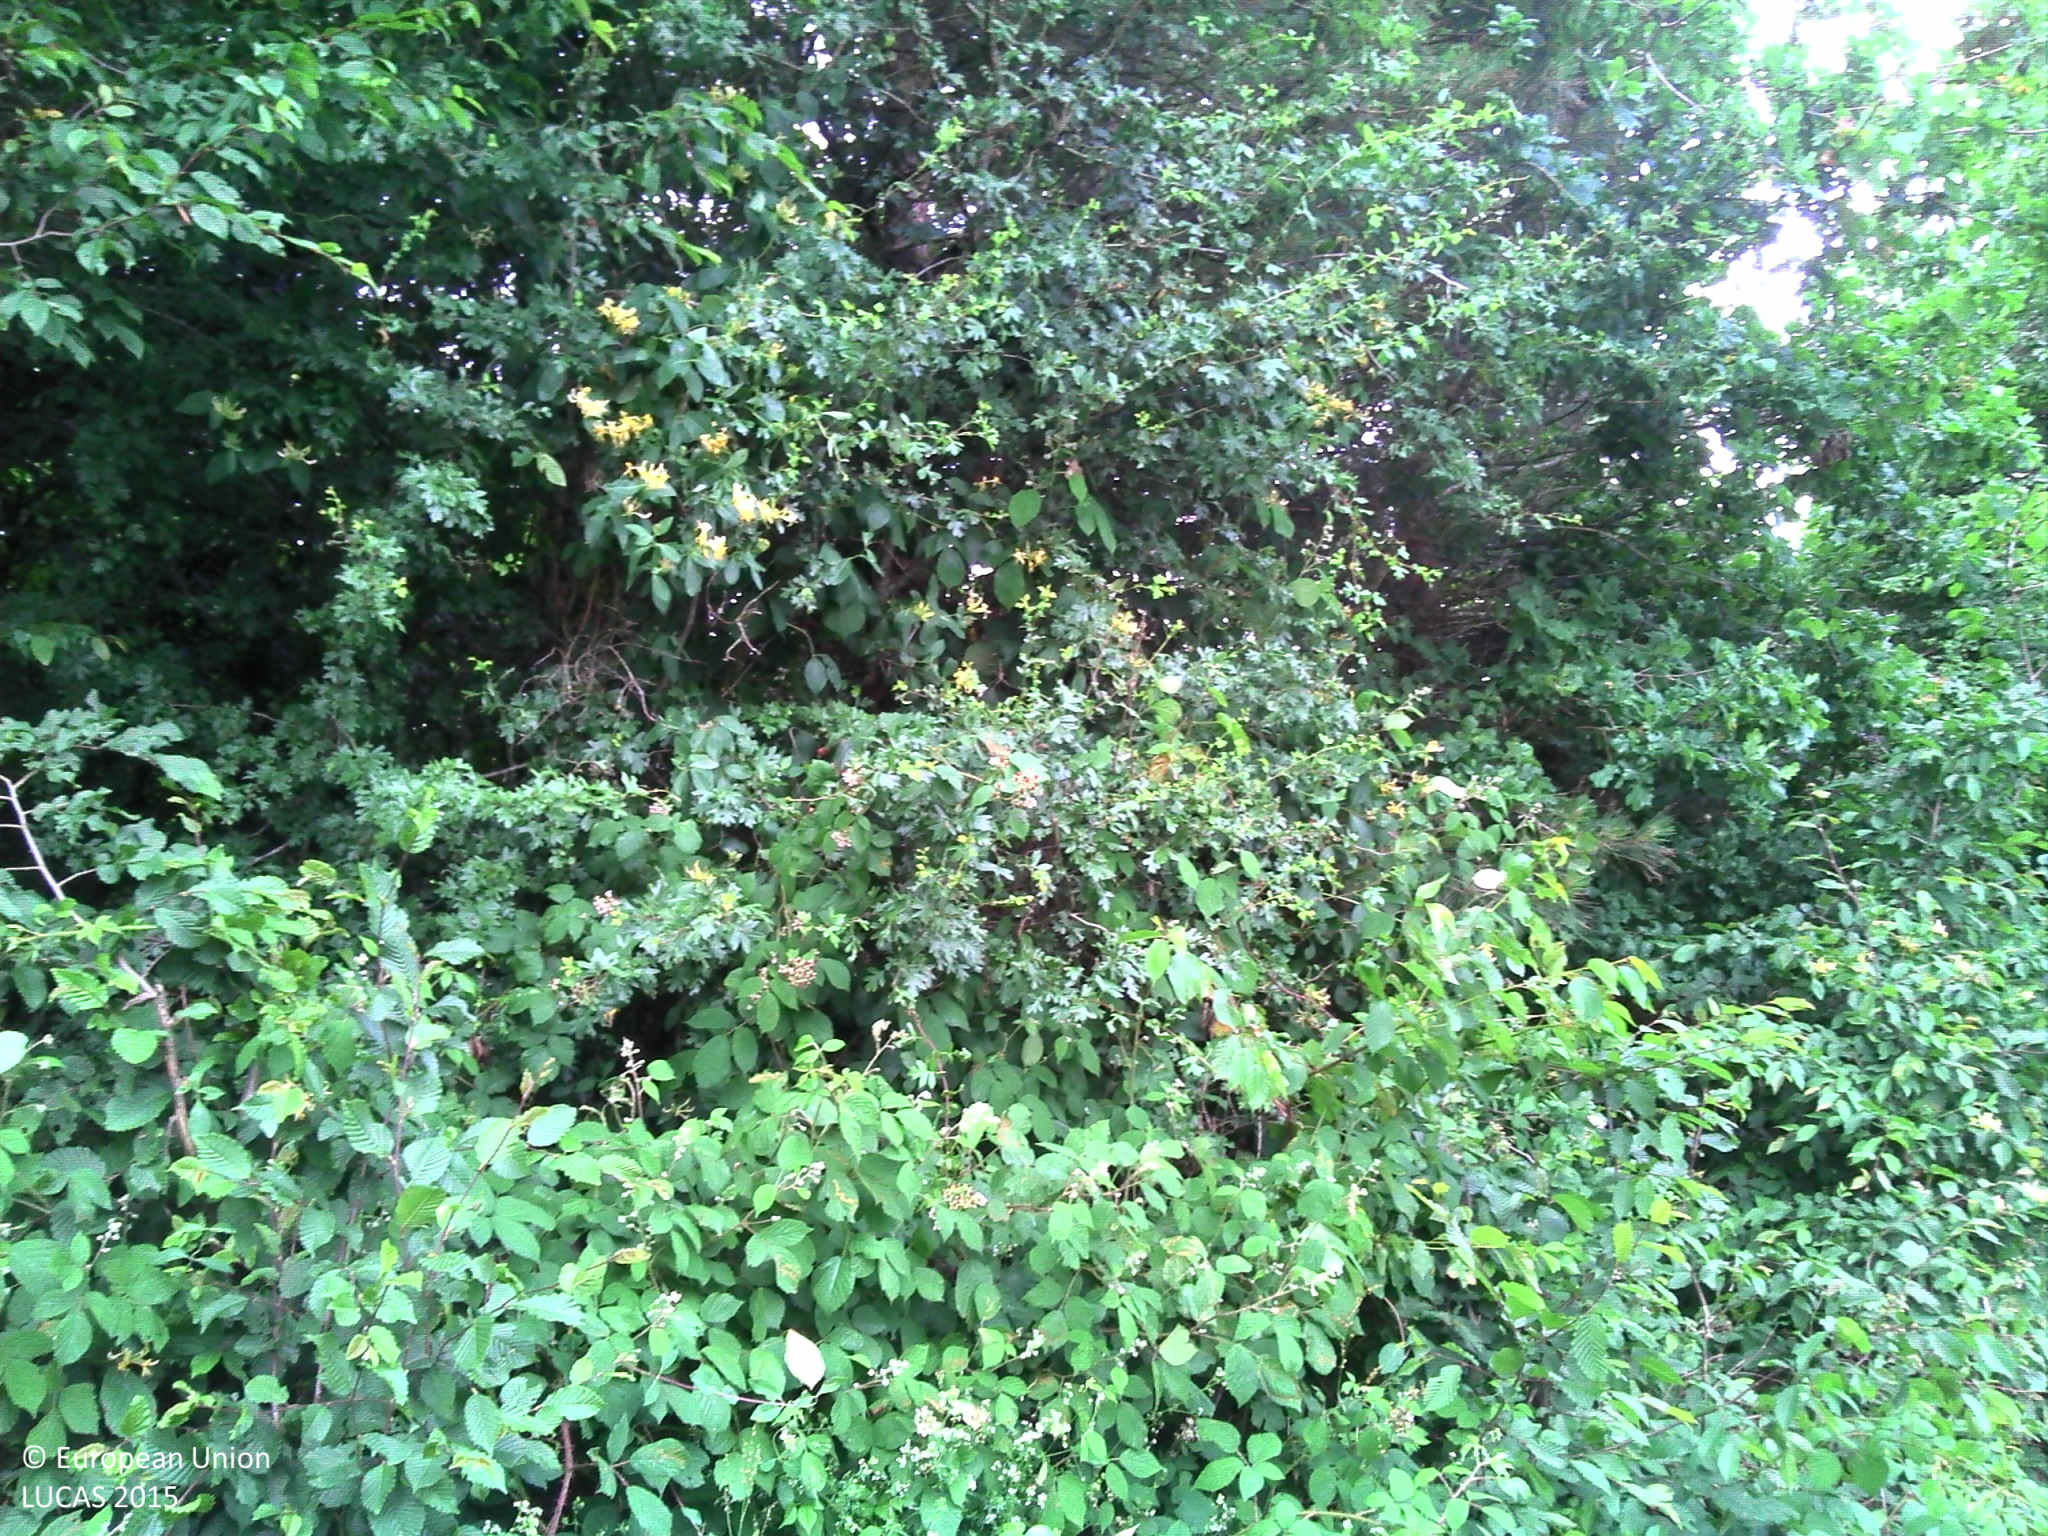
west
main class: Woodland
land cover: Broadleaved woodland
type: mesophytic deciduous forest
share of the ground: > 75 %
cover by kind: broadleaved forest trees 90 %, shrubs 5 %, herbaceous plants 5 %
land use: Forestry
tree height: > 5 m
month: June
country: FR
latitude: 46.3042
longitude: 3.0256
